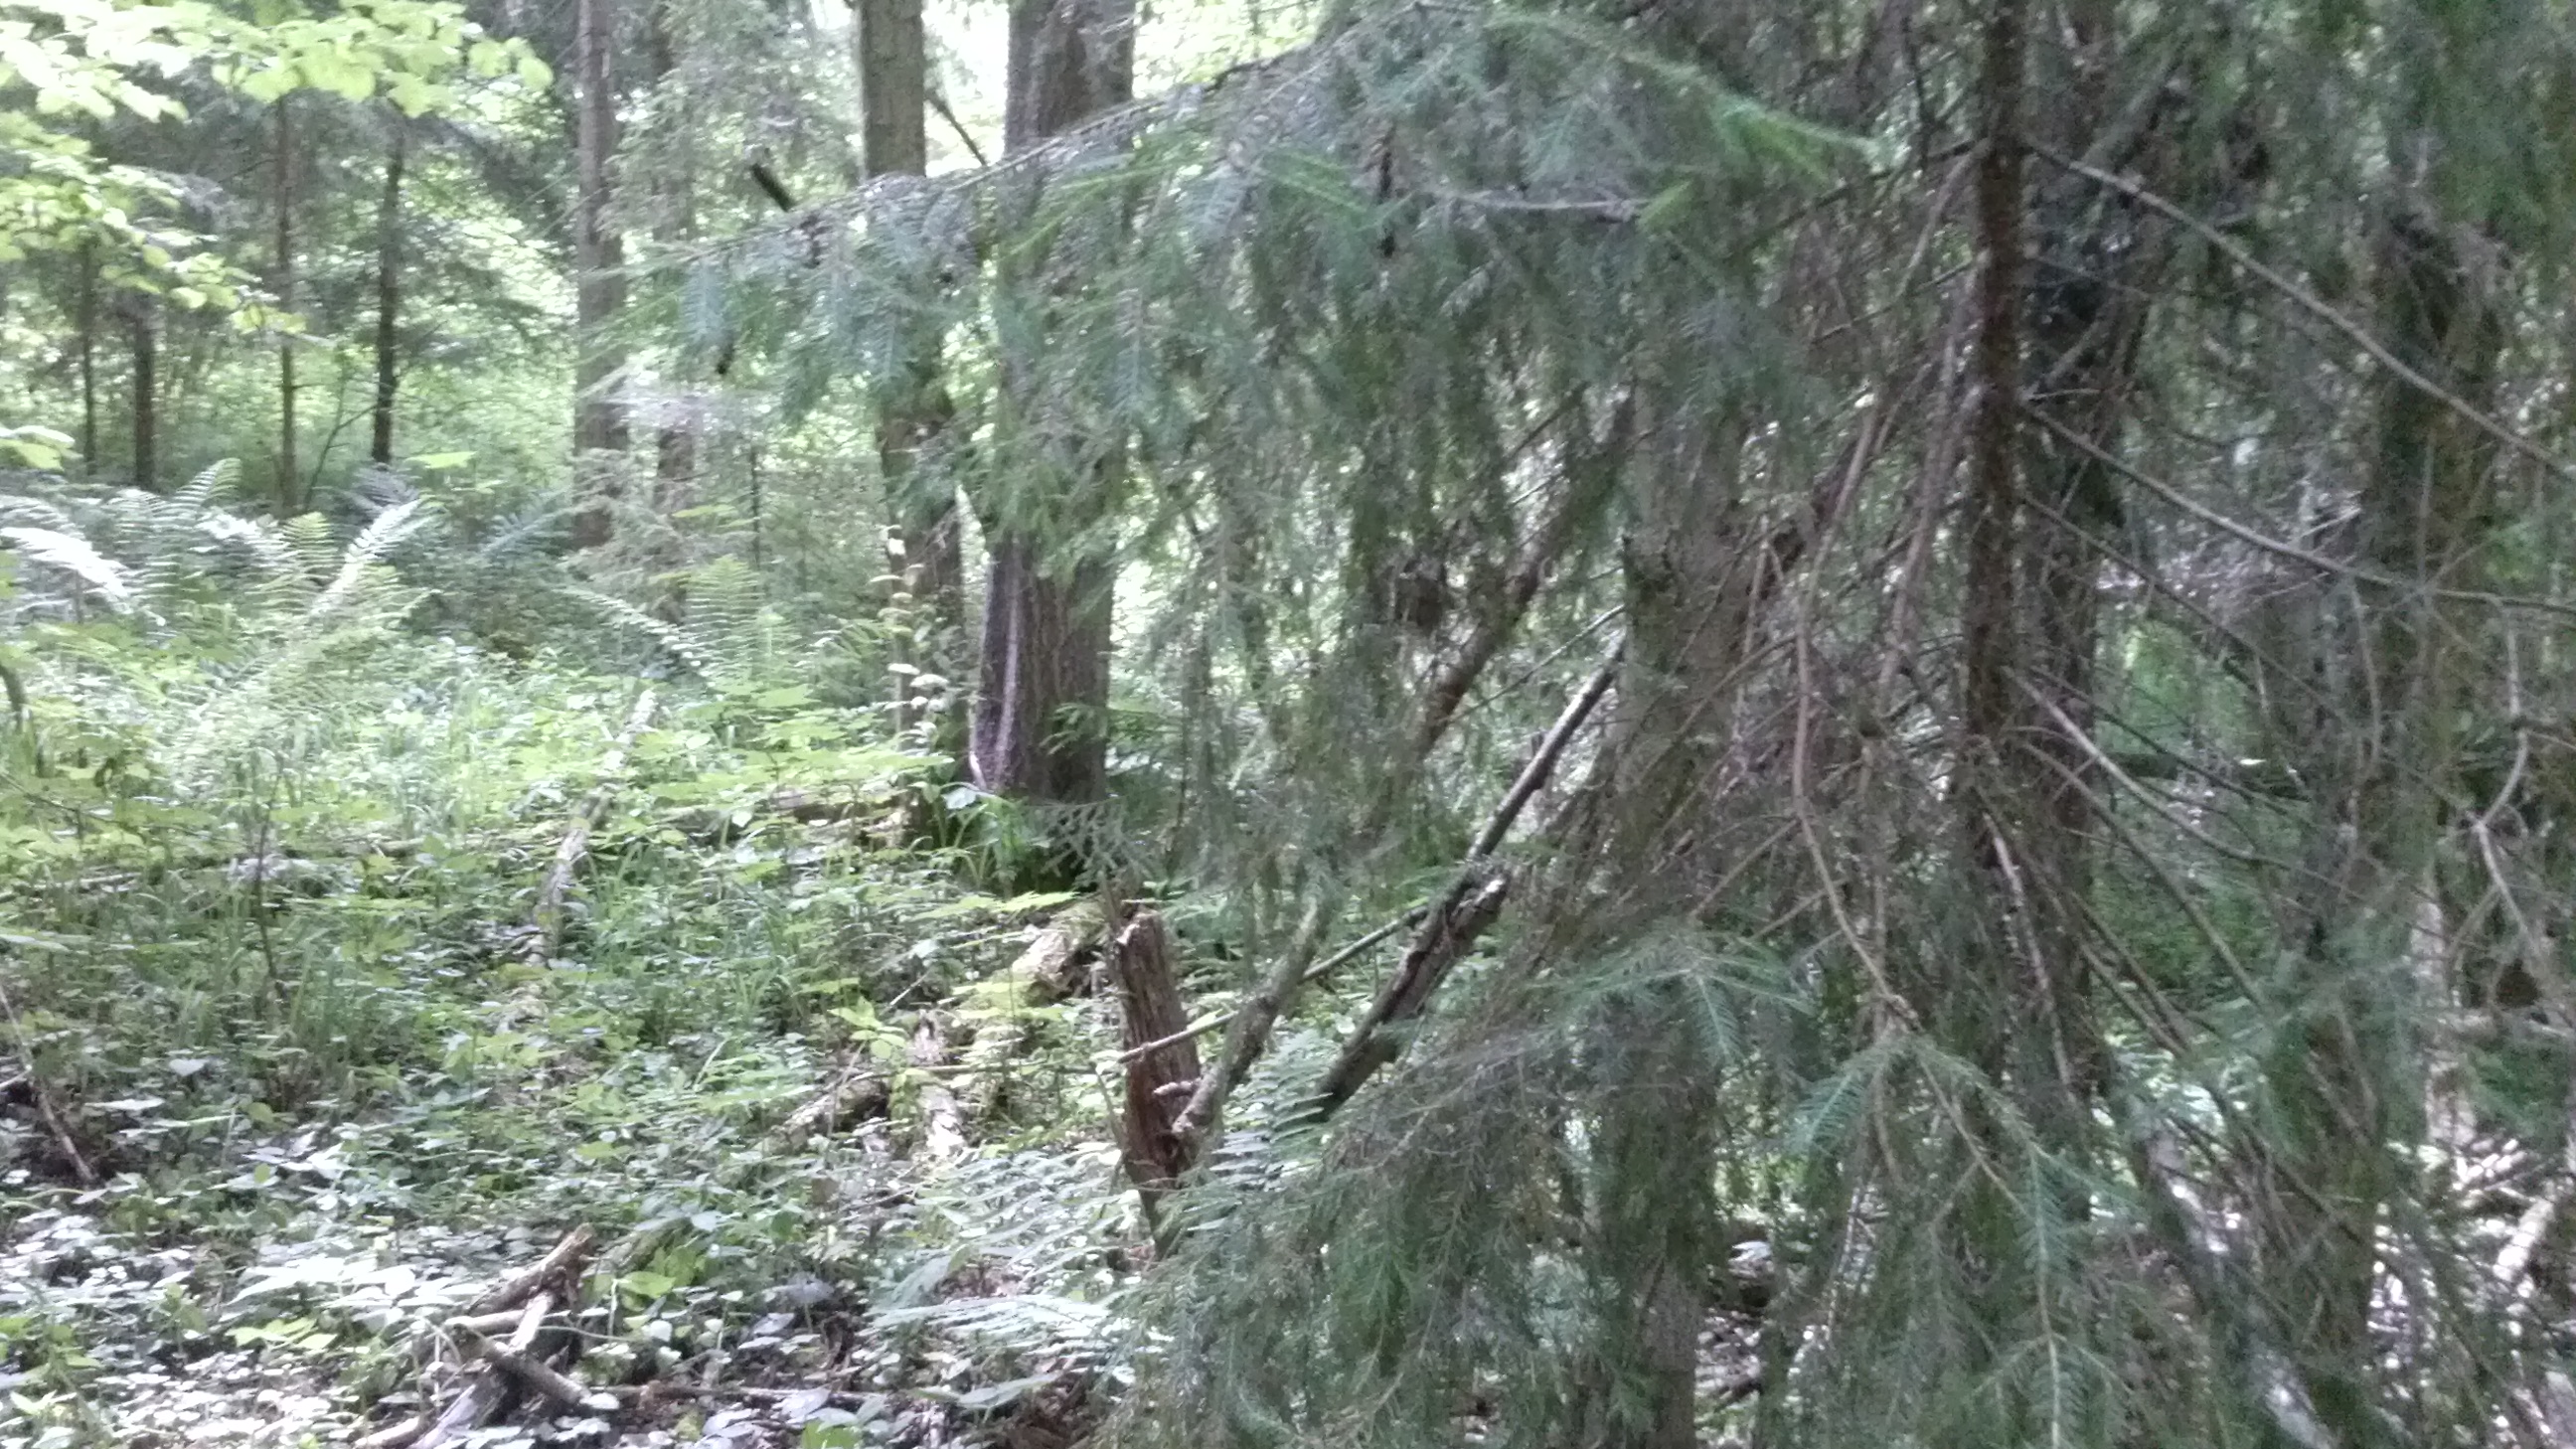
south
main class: Woodland
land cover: Spruce dominated mixed woodland
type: hemiboreal forest and nemoral coniferous forest and mixed broadleaved-coniferous forest
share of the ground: > 75 %
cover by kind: coniferous forest trees 55 %, broadleaved forest trees 30 %, herbaceous plants 10 %, shrubs 5 %
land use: Forestry
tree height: > 5 m
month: June
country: LV
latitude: 56.5784
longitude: 27.7524
